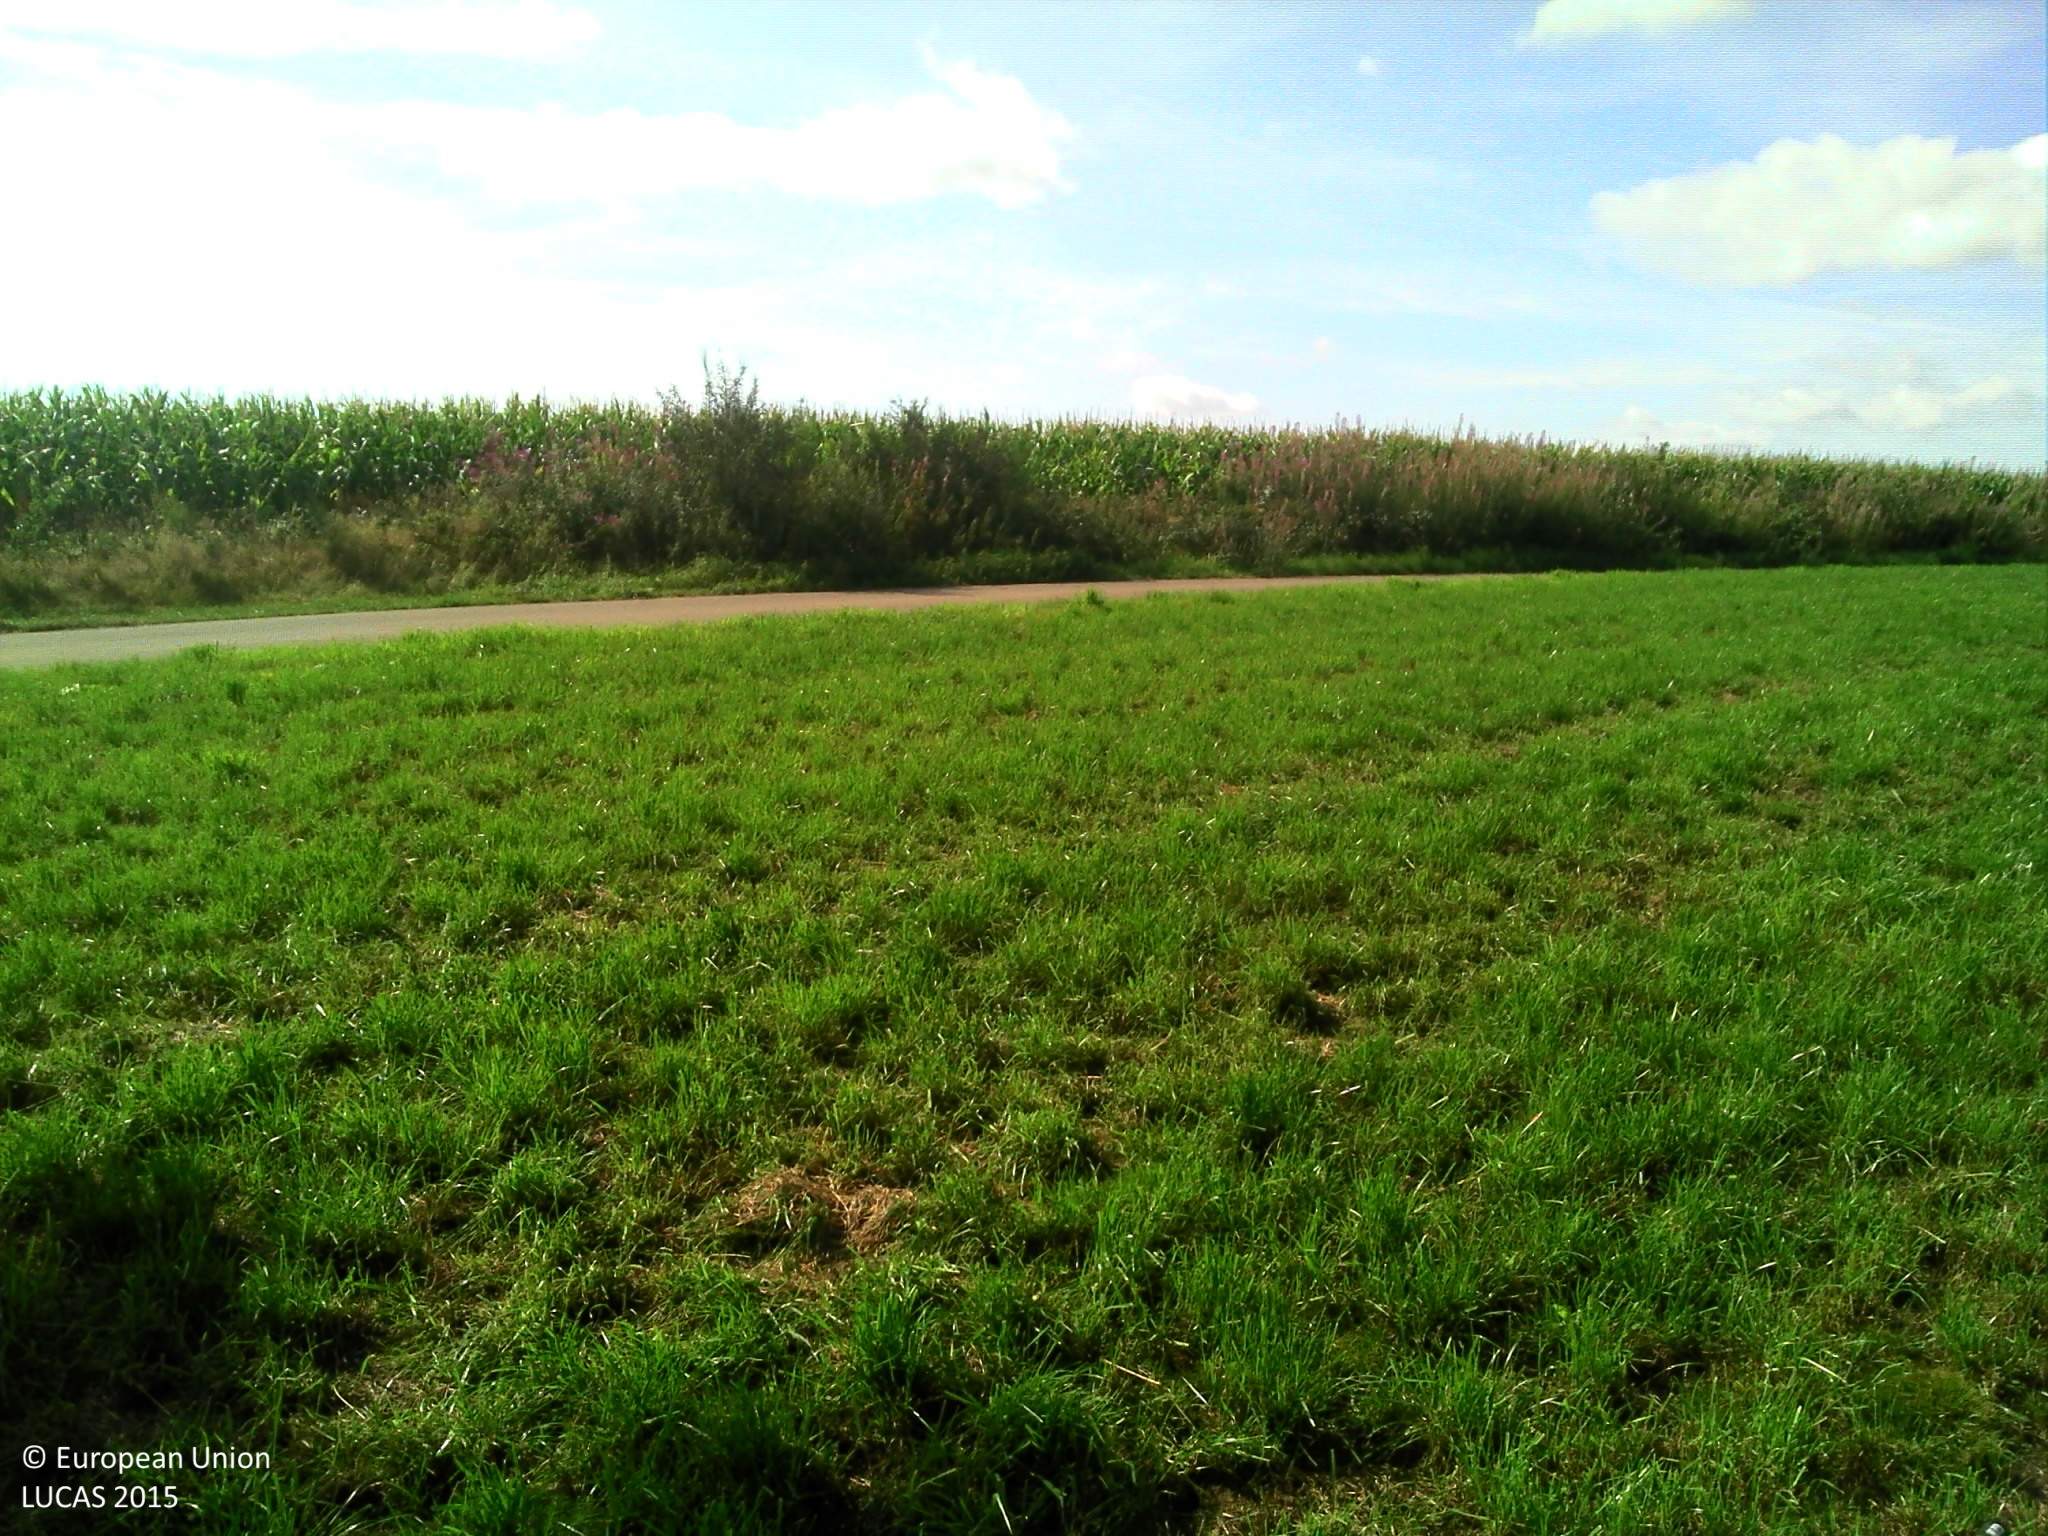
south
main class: Cropland
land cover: Temporary grasslands
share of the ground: > 75 %
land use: Agriculture (excluding fallow land and kitchen gardens)
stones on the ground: < 10 %
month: August
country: LU
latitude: 50.0747
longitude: 5.9049
